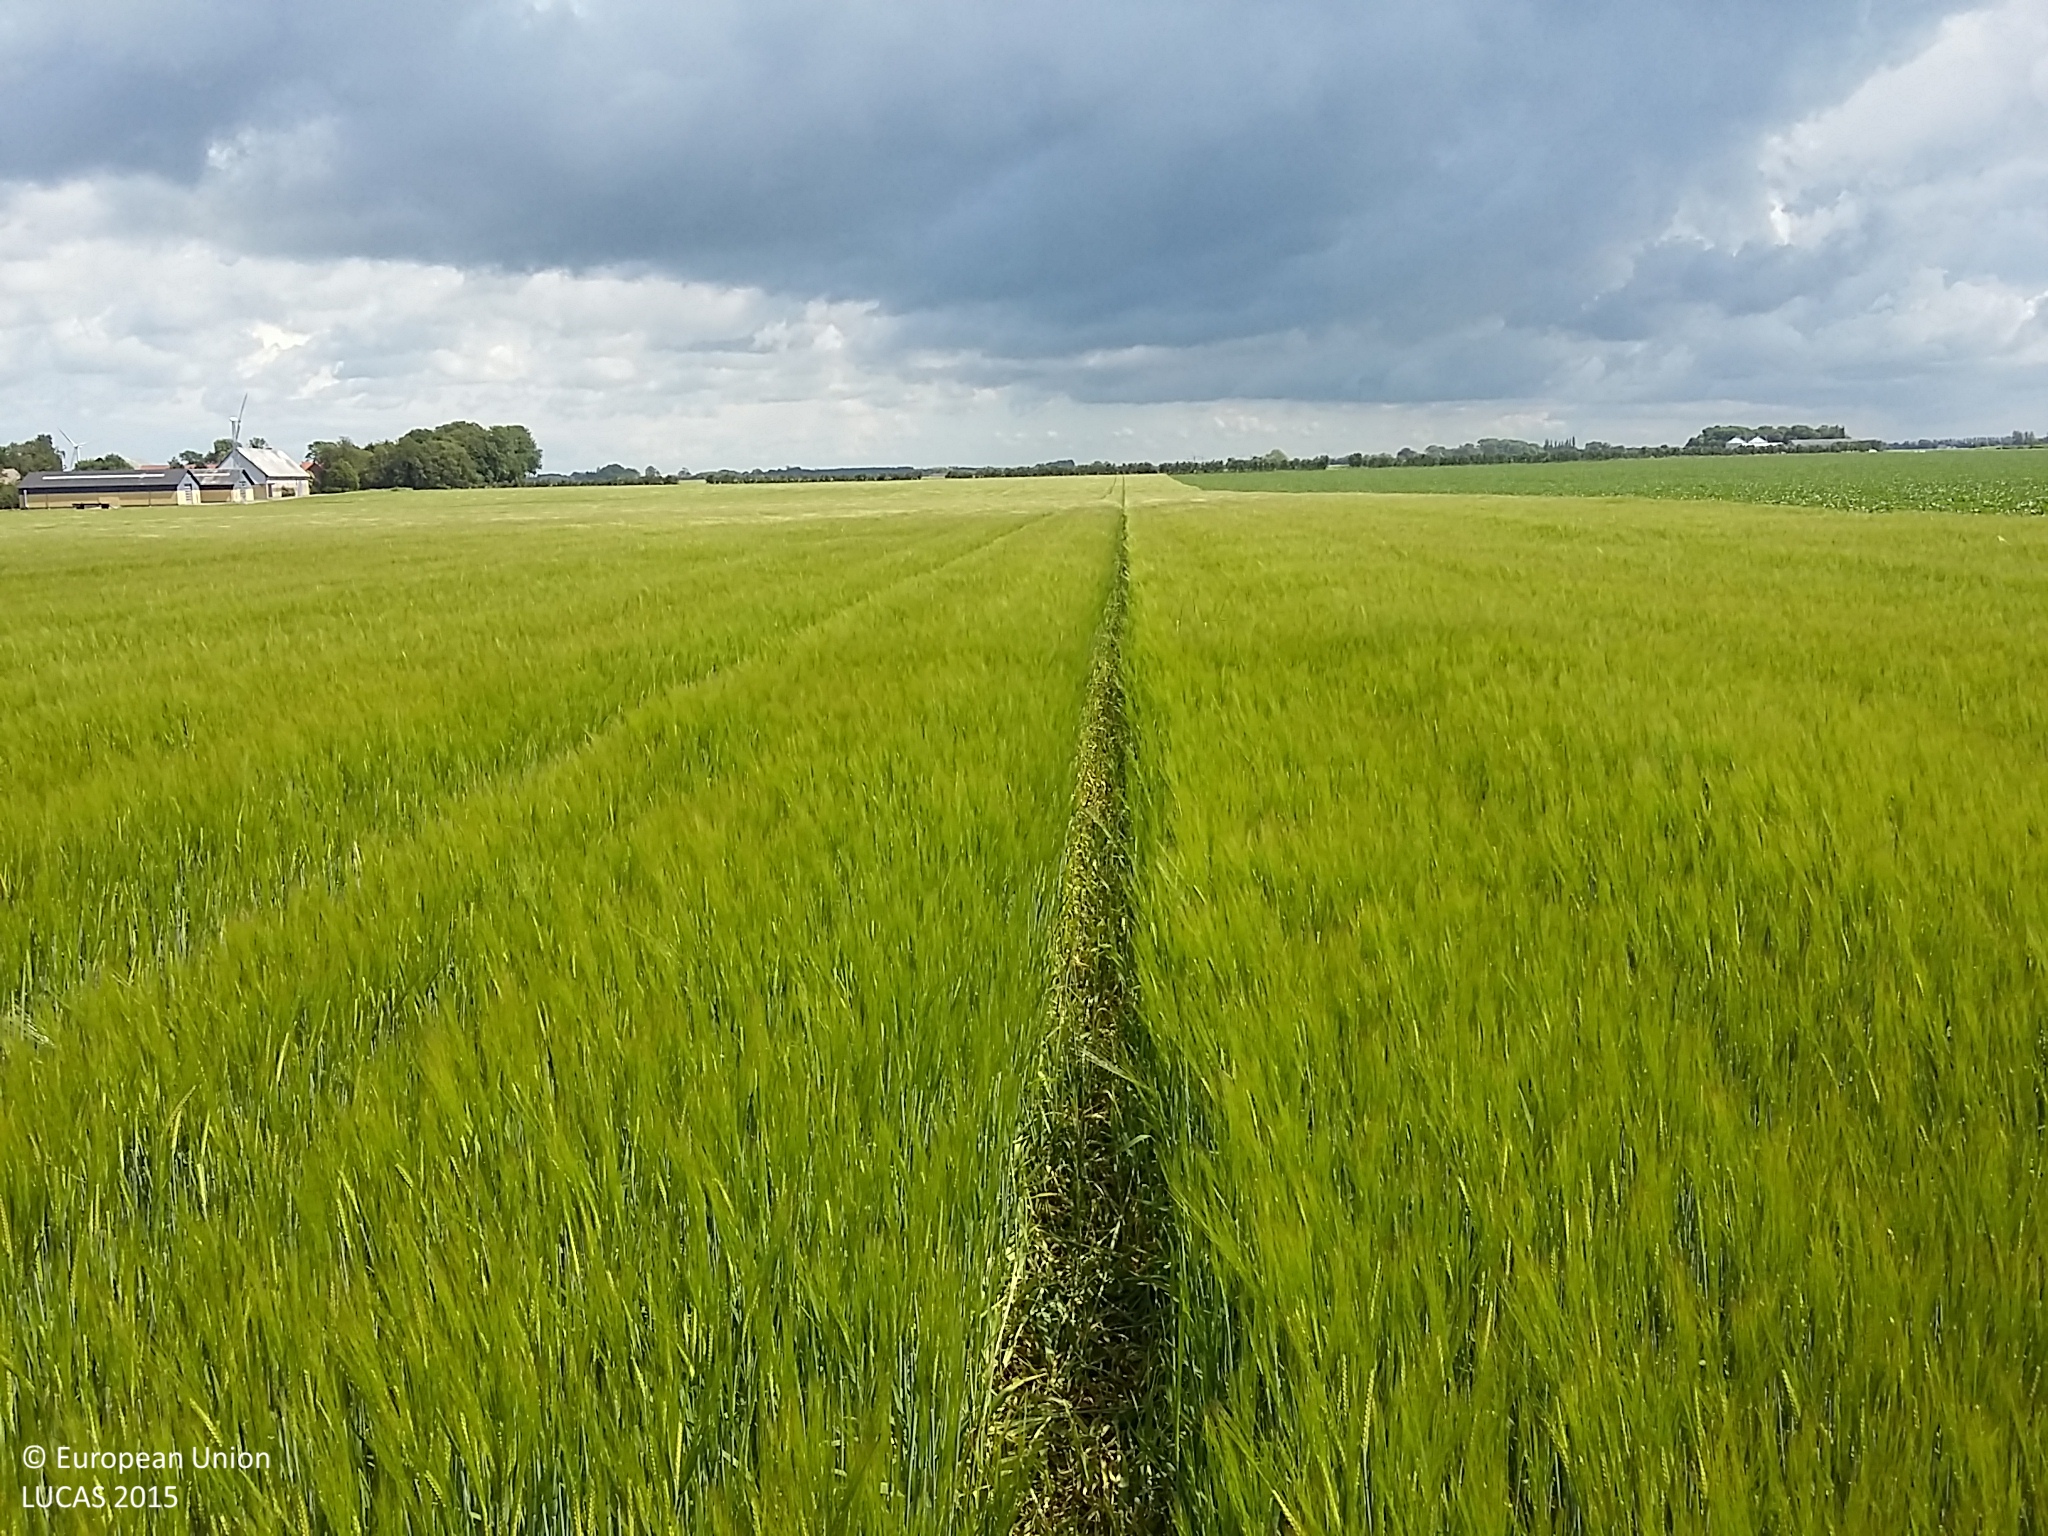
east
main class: Cropland
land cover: Barley
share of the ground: > 75 %
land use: Agriculture (excluding fallow land and kitchen gardens)
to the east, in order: Barley
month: June
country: DK
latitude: 54.7986
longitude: 11.1347
